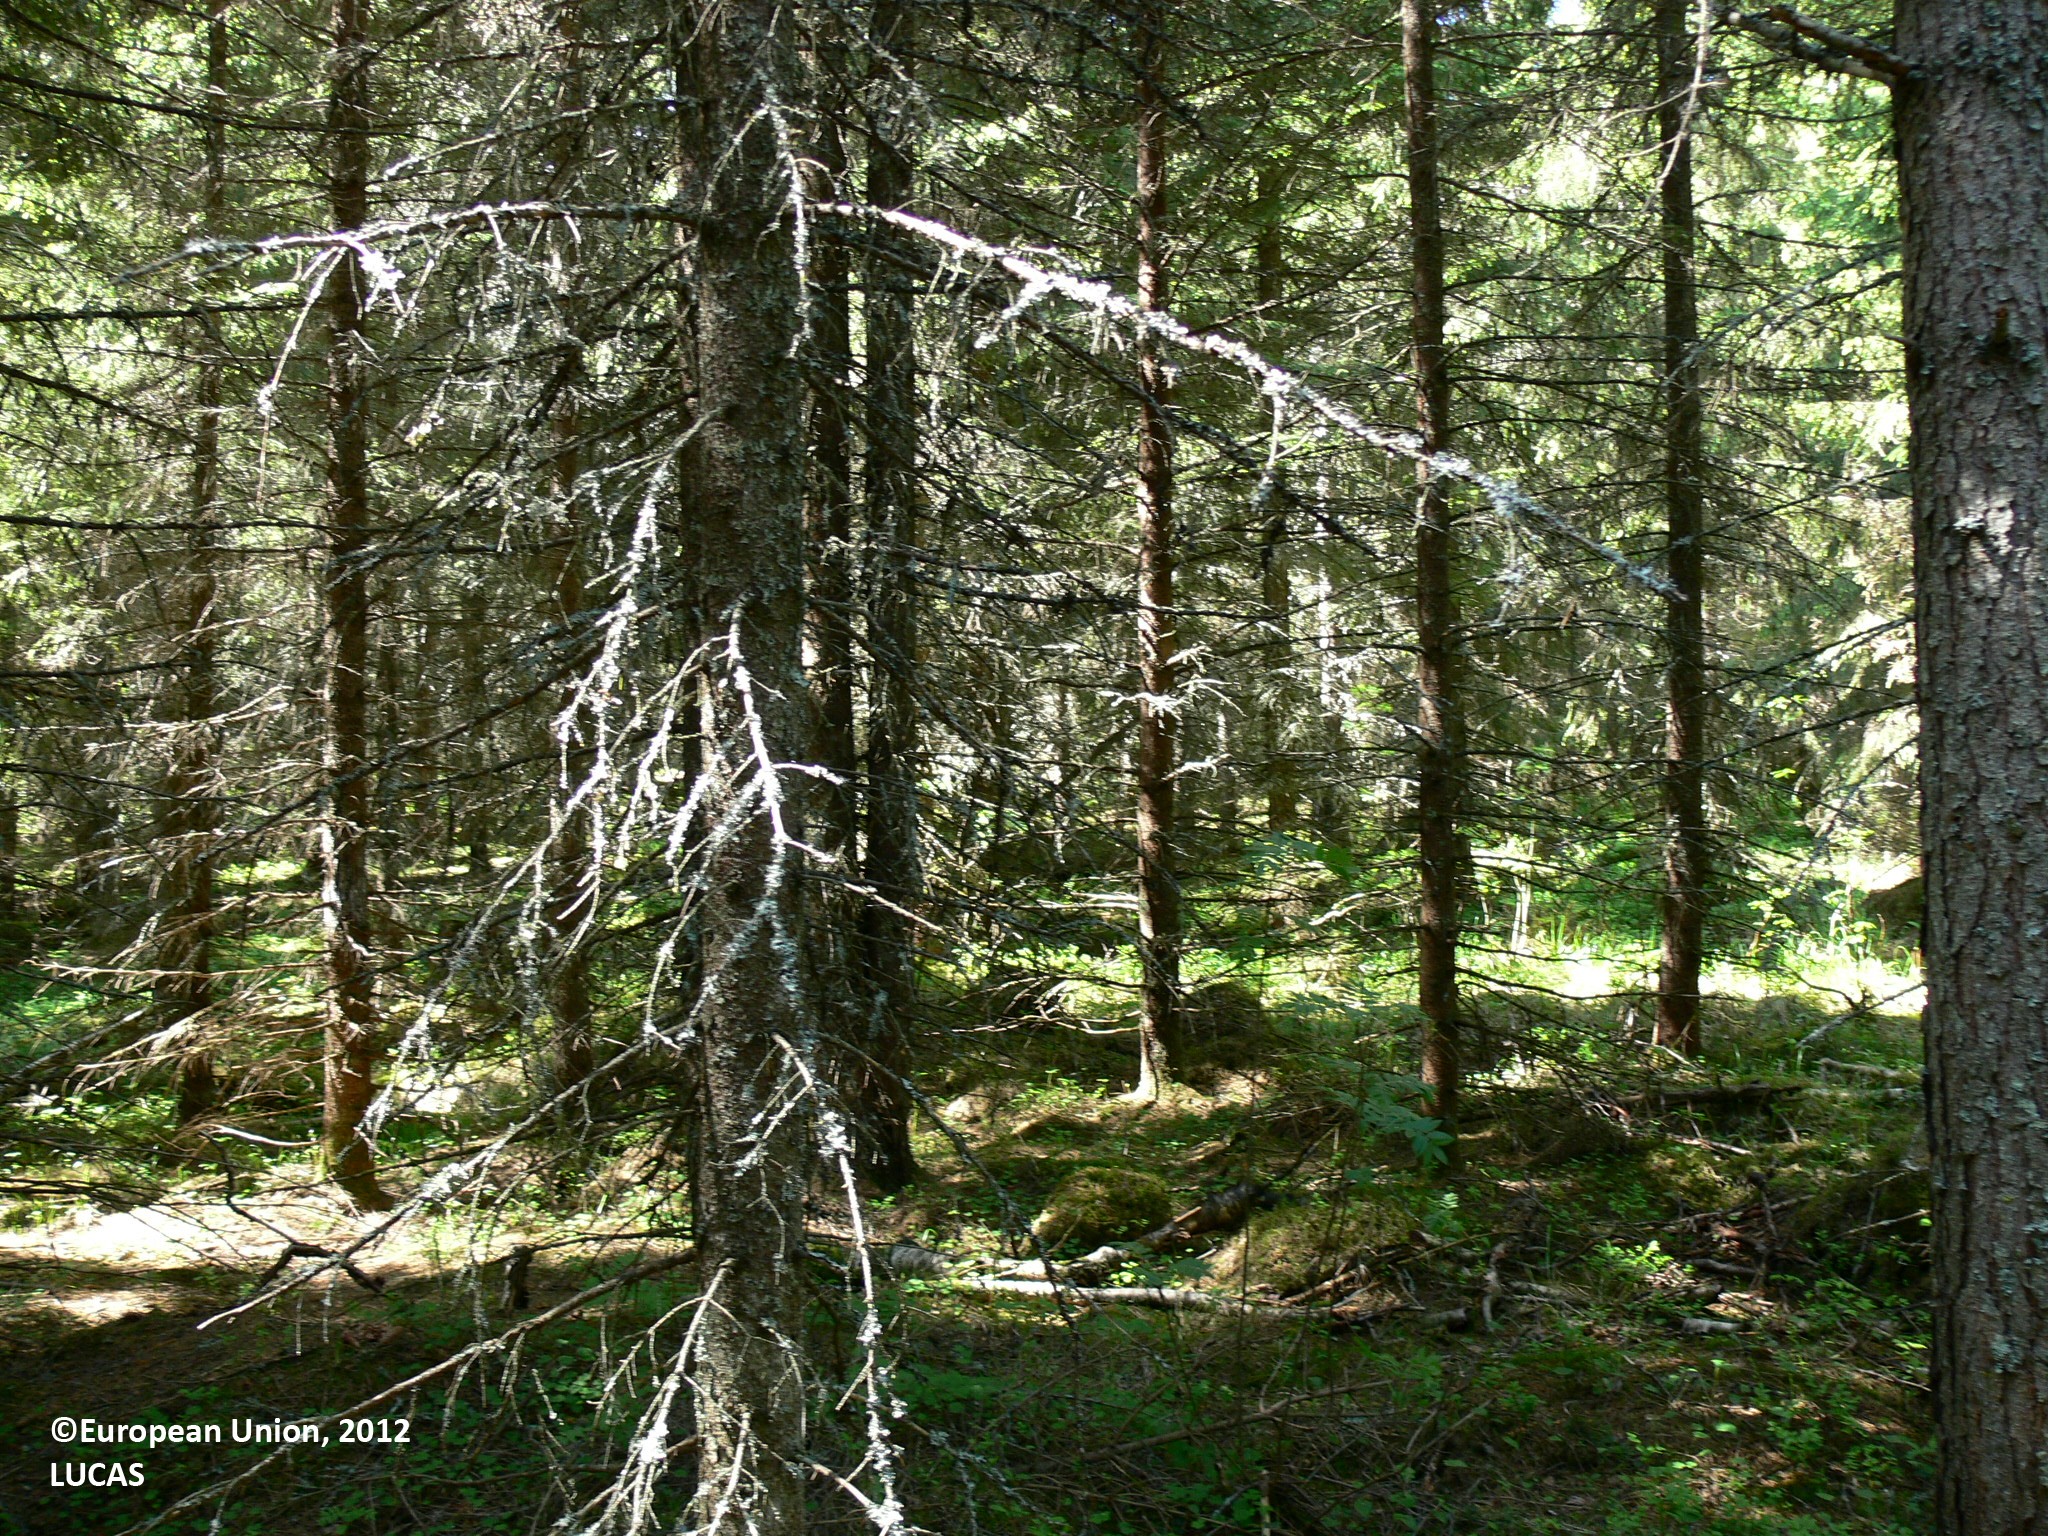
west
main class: Woodland
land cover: Spruce dominated coniferous woodland
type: boreal forest
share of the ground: > 75 %
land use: Forestry
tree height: > 5 m
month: June
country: FI
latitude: 62.5798
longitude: 30.3832
